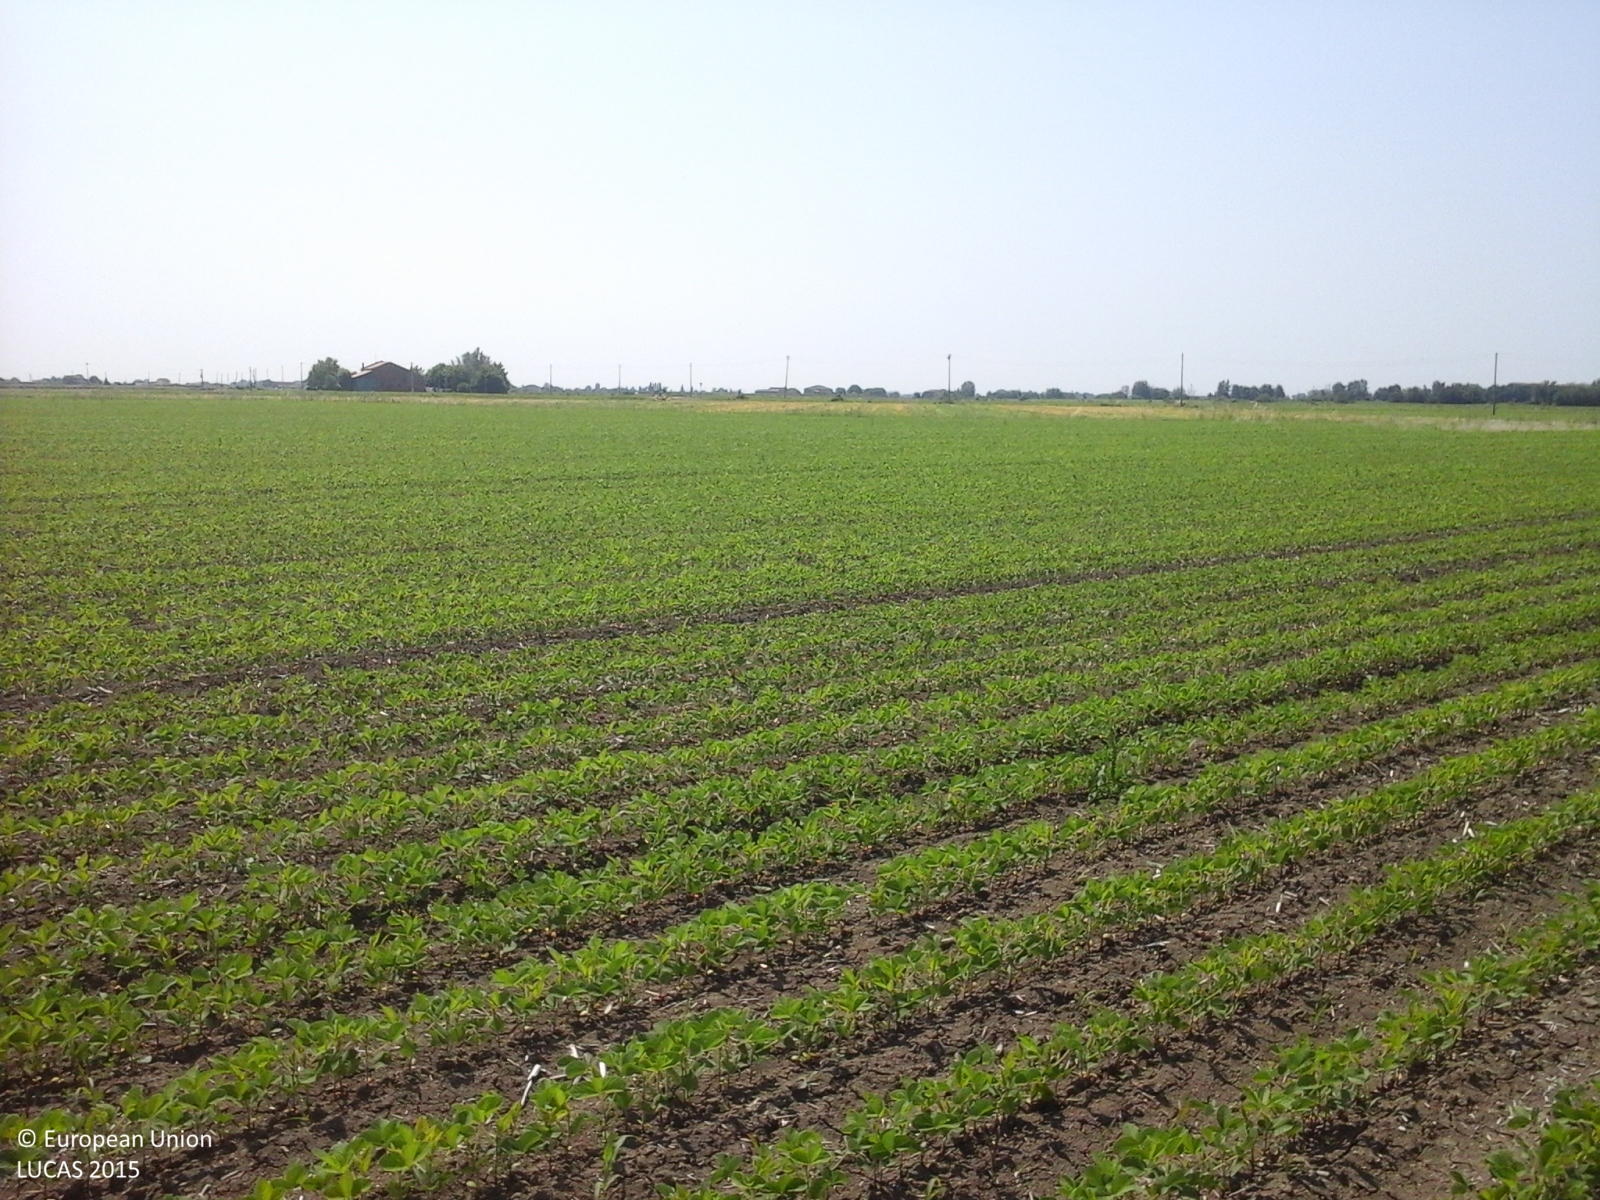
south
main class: Cropland
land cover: Soya
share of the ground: 10 - 25 %
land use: Agriculture (excluding fallow land and kitchen gardens)
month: May
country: IT
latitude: 44.7695
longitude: 11.7024
